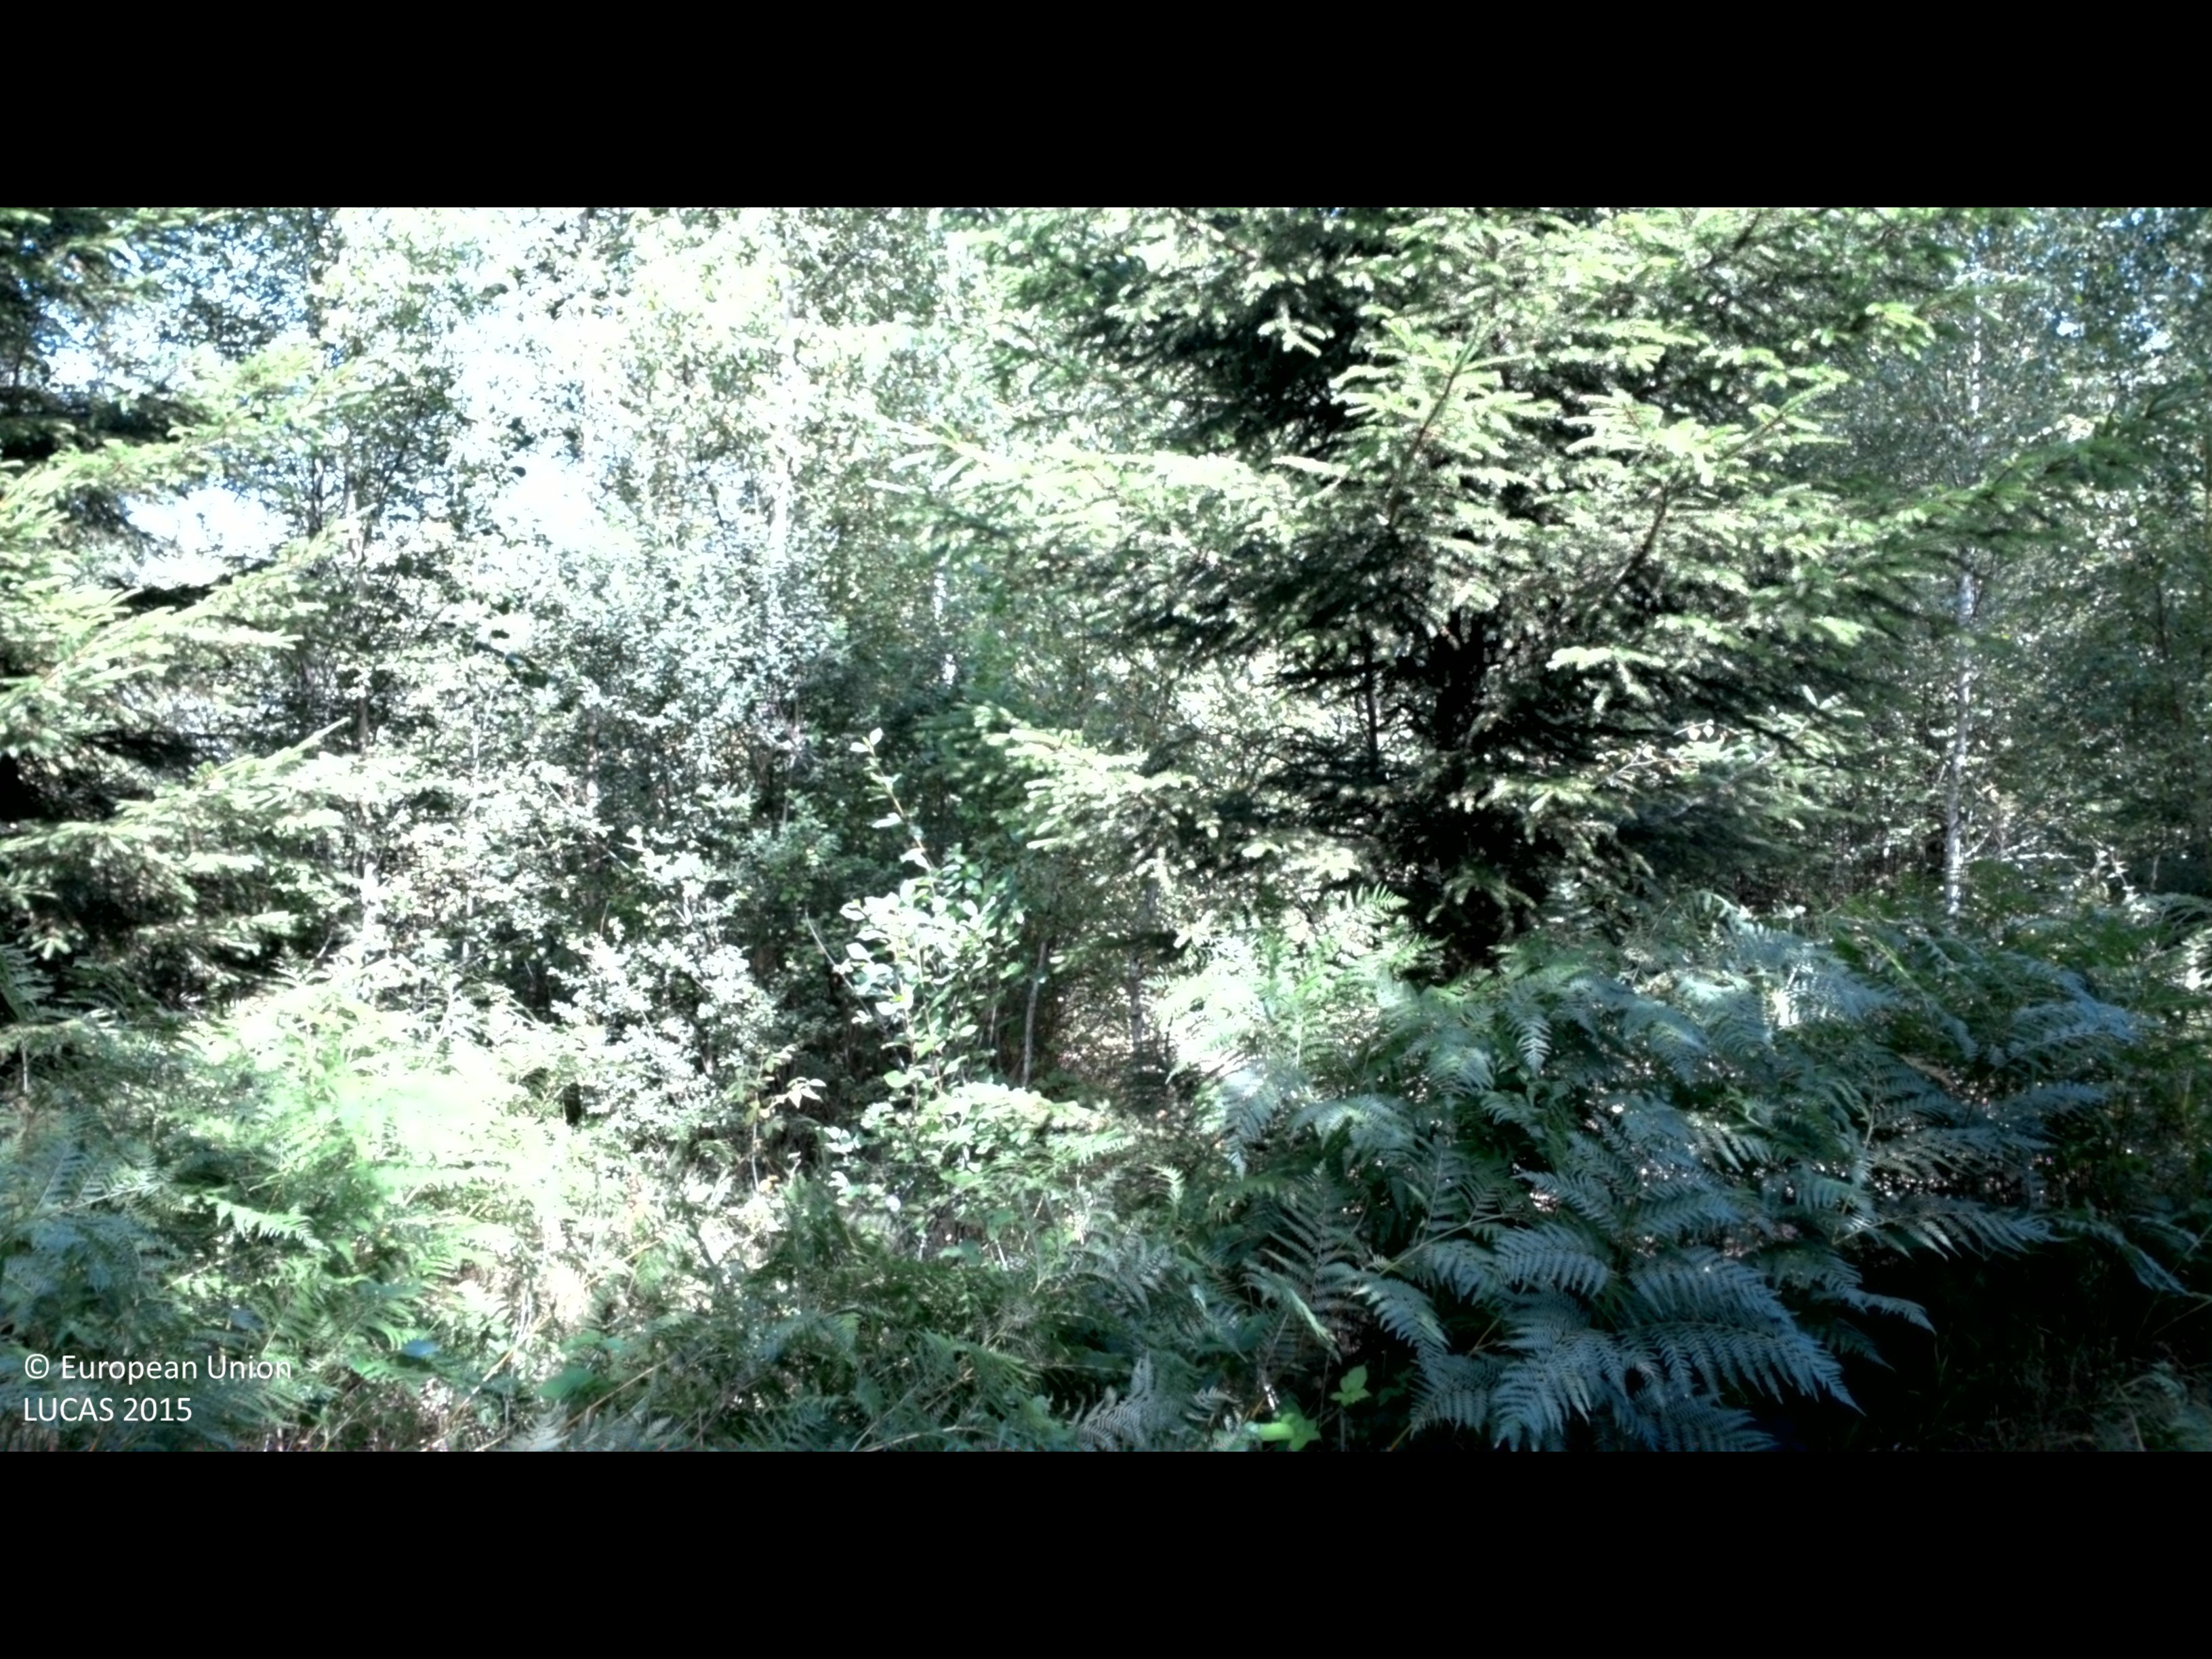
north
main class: Woodland
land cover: Spruce dominated mixed woodland
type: boreal forest
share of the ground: 50 - 75 %
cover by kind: coniferous forest trees 40 %, herbaceous plants 30 %, broadleaved forest trees 25 %, shrubs 5 %
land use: Forestry
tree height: > 5 m
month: August
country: SE
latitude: 56.2867
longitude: 15.8969
